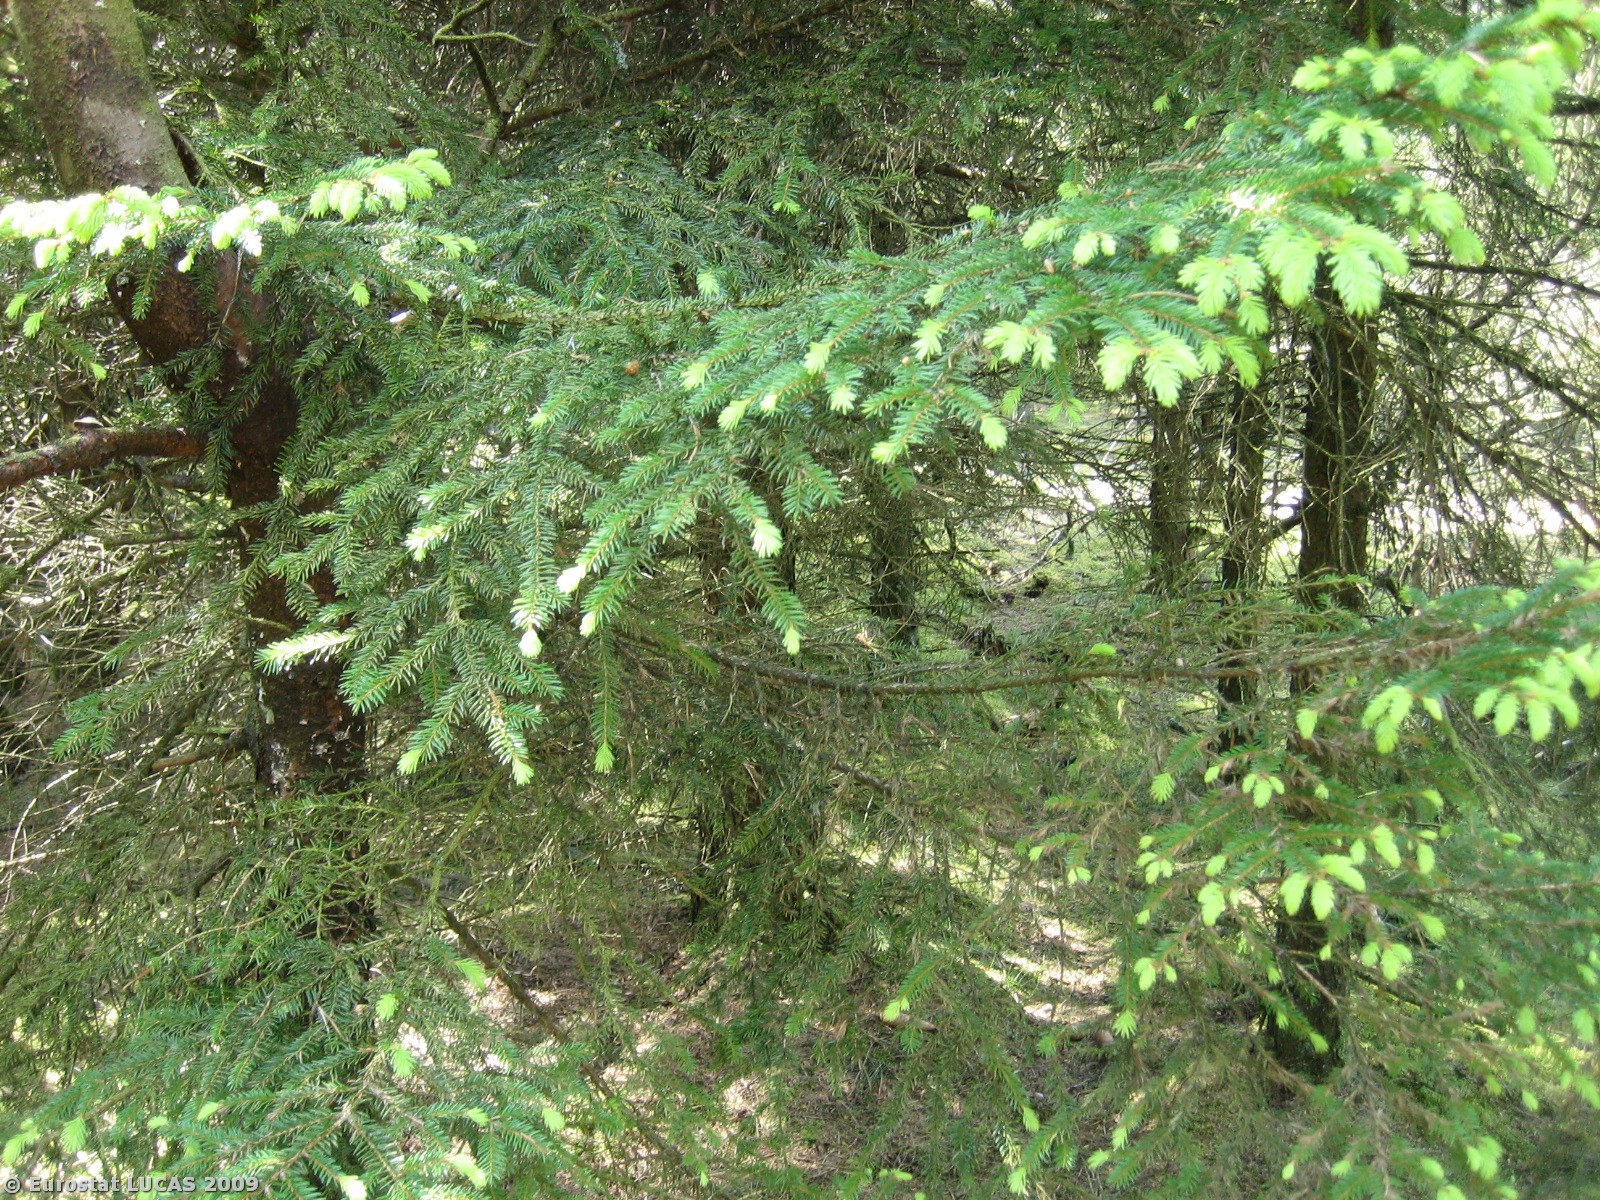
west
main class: Woodland
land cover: Coniferous woodland
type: hemiboreal forest and nemoral coniferous forest and mixed broadleaved-coniferous forest
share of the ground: > 75 %
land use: Forestry
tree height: > 5 m
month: May
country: DK
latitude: 56.2546
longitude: 8.8553
